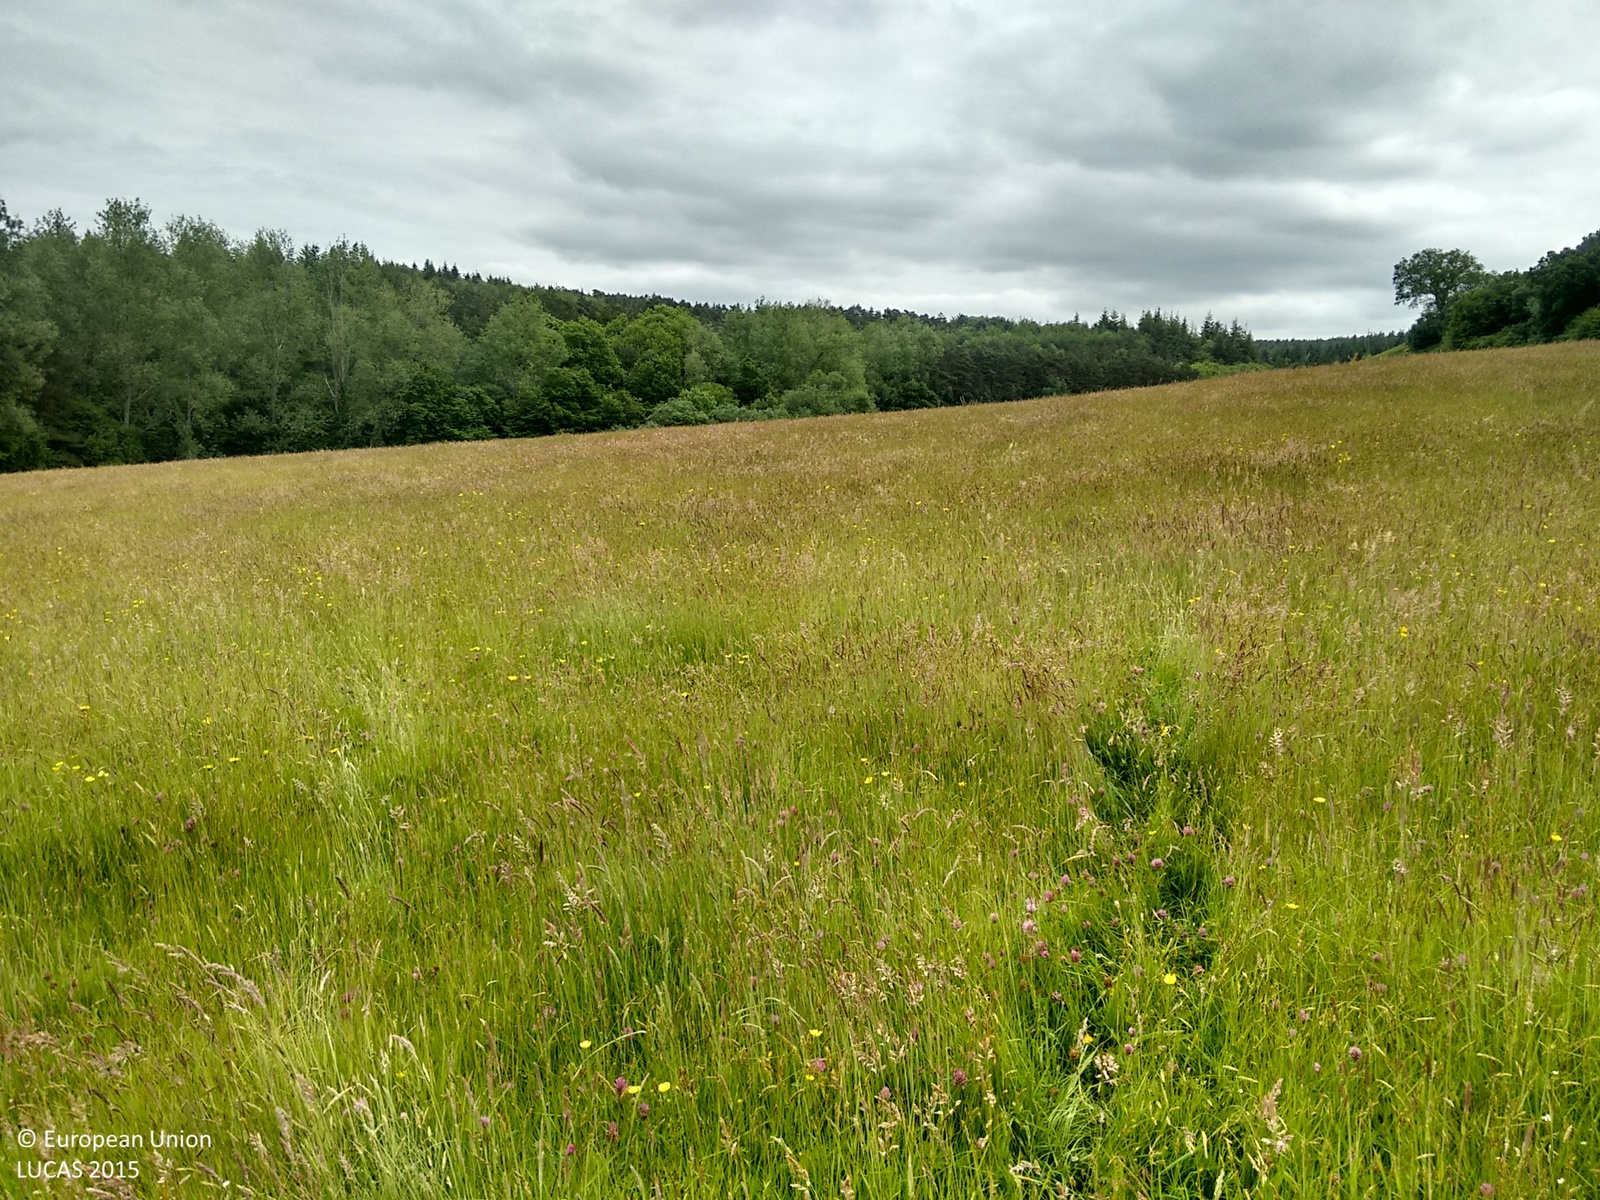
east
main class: Grassland
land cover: Grassland without tree/shrub cover
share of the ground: > 75 %
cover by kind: herbaceous plants 100 %
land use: Agriculture (excluding fallow land and kitchen gardens)
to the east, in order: Grassland without tree/shrub cover; Fences; Broadleaved woodland
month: June
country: GB
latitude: 50.9214
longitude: 0.4261
